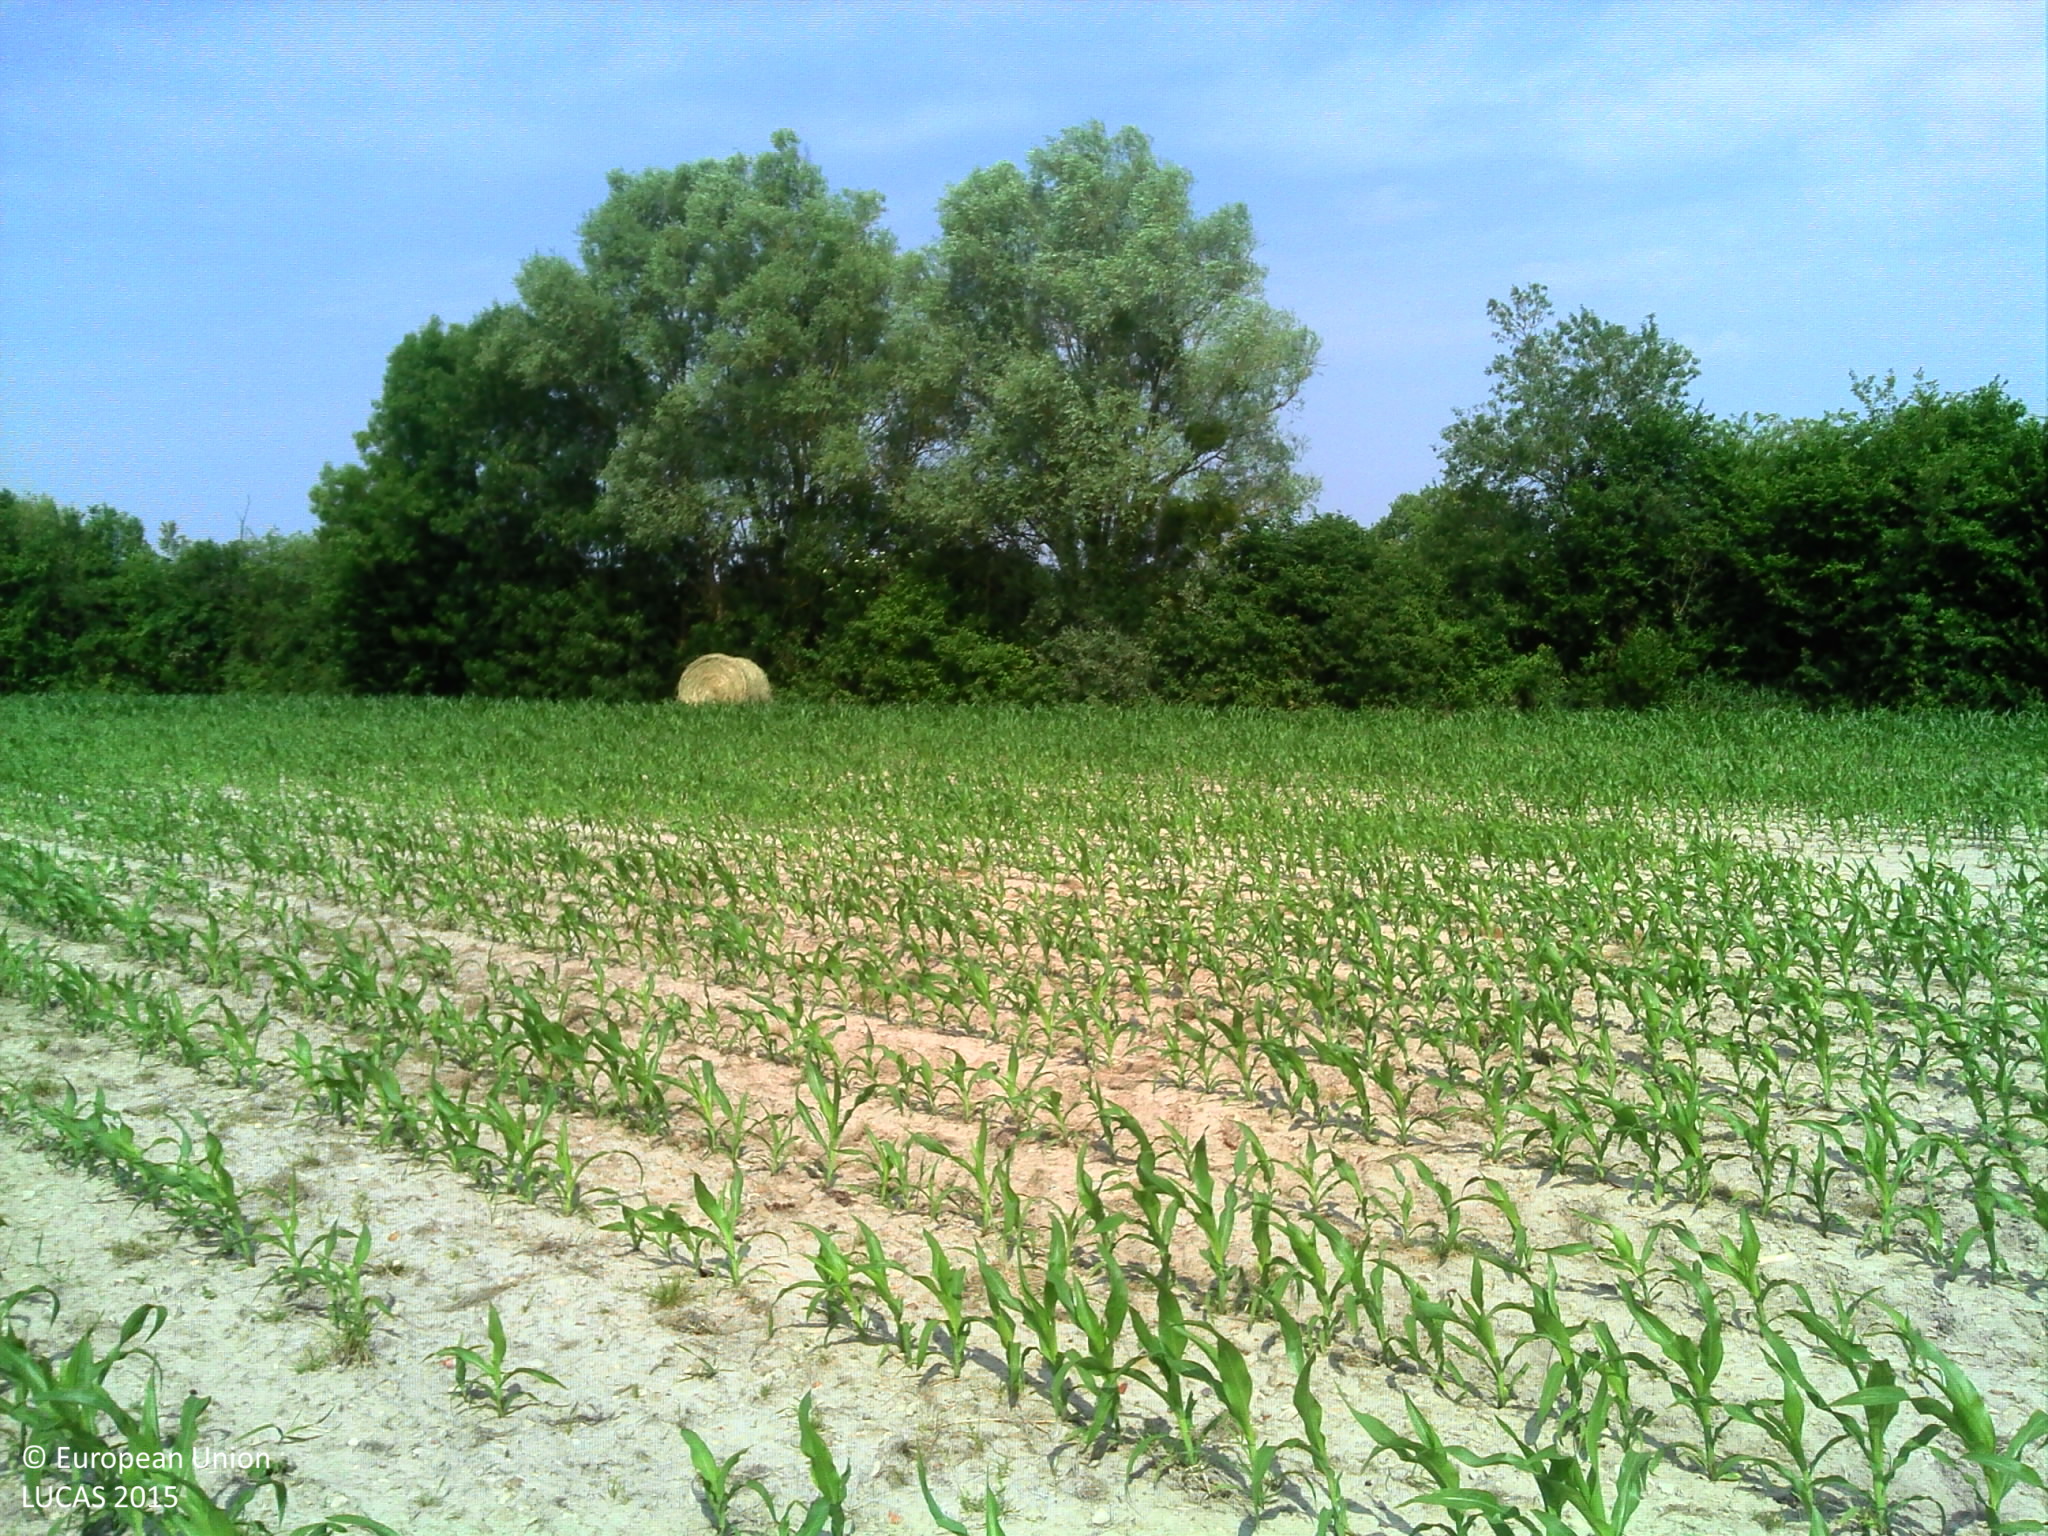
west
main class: Cropland
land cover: Maize
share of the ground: 10 - 25 %
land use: Agriculture (excluding fallow land and kitchen gardens)
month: June
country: FR
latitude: 47.5950
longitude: 0.0933
